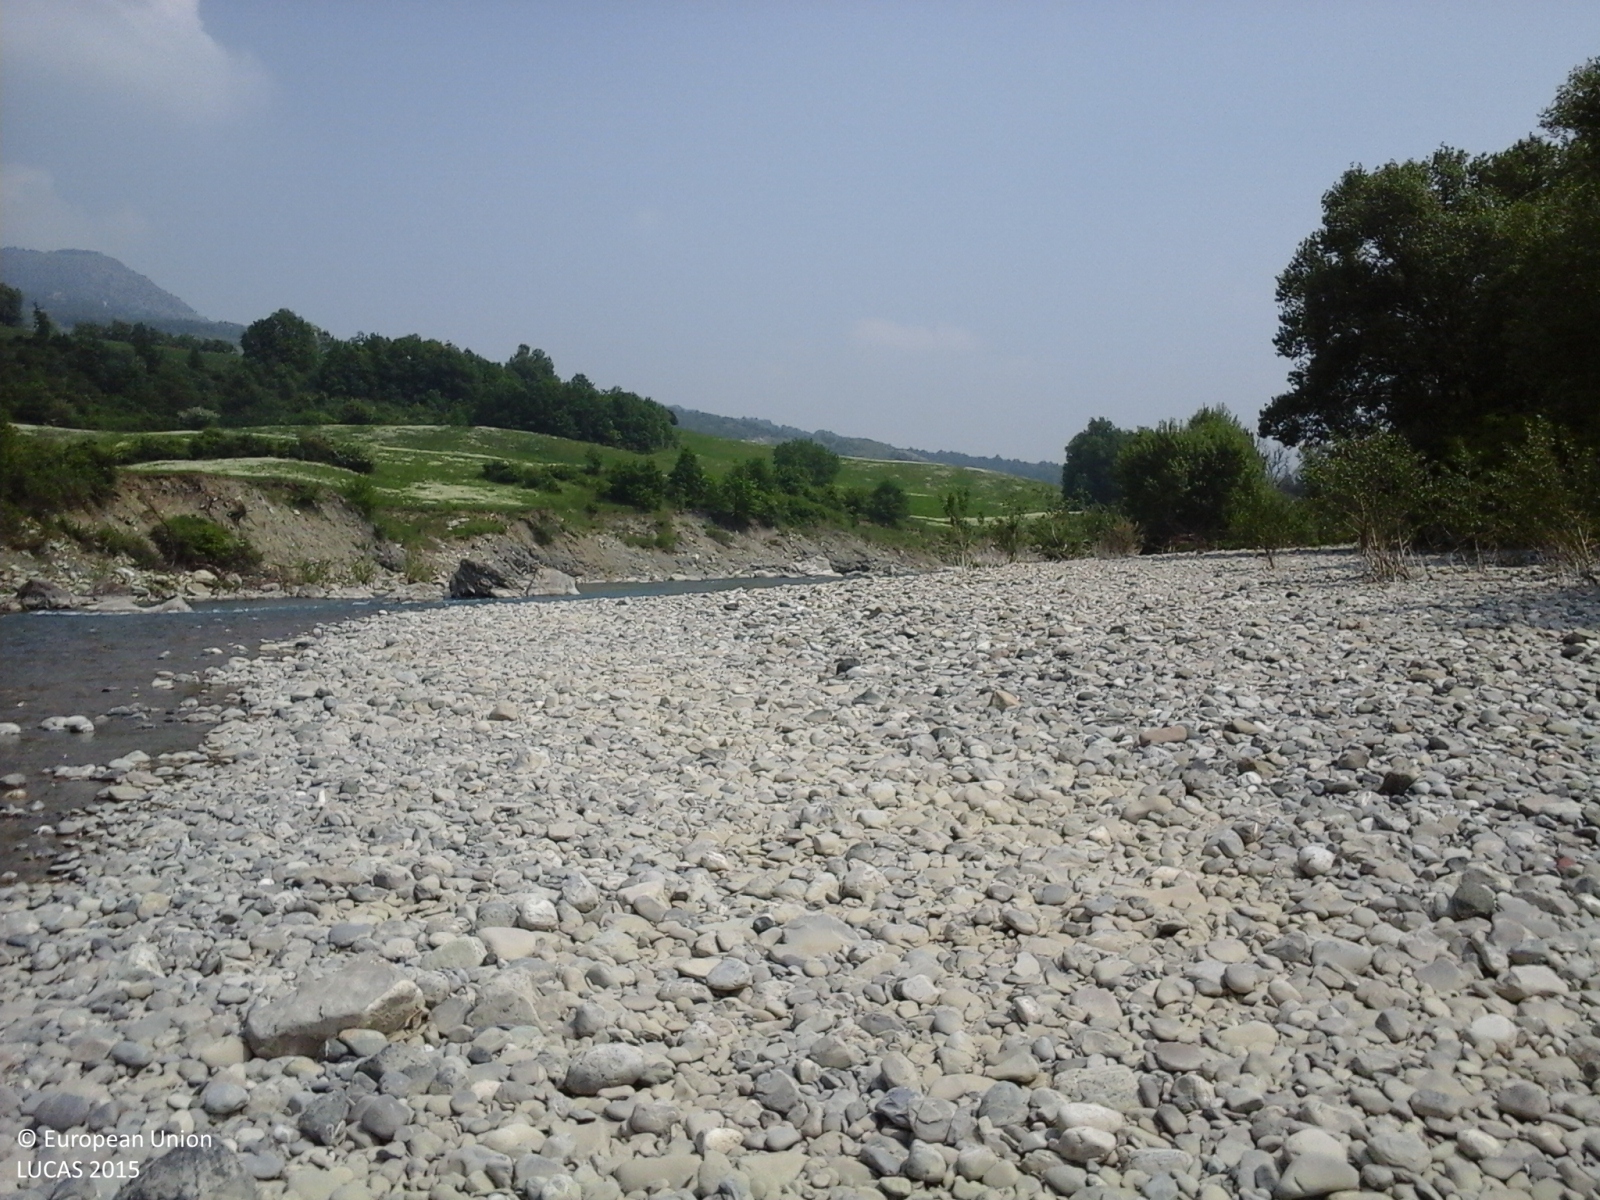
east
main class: Woodland
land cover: Broadleaved woodland
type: mesophytic deciduous forest
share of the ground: > 75 %
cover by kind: broadleaved forest trees 85 %, shrubs 15 %
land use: Forestry
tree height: > 5 m
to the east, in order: Broadleaved woodland; Tracks; Broadleaved woodland; Tracks; Broadleaved woodland; Tracks; Broadleaved woodland; Lucerne; Shrubland with sparse tree cover
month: May
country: IT
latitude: 44.8180
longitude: 9.4573
